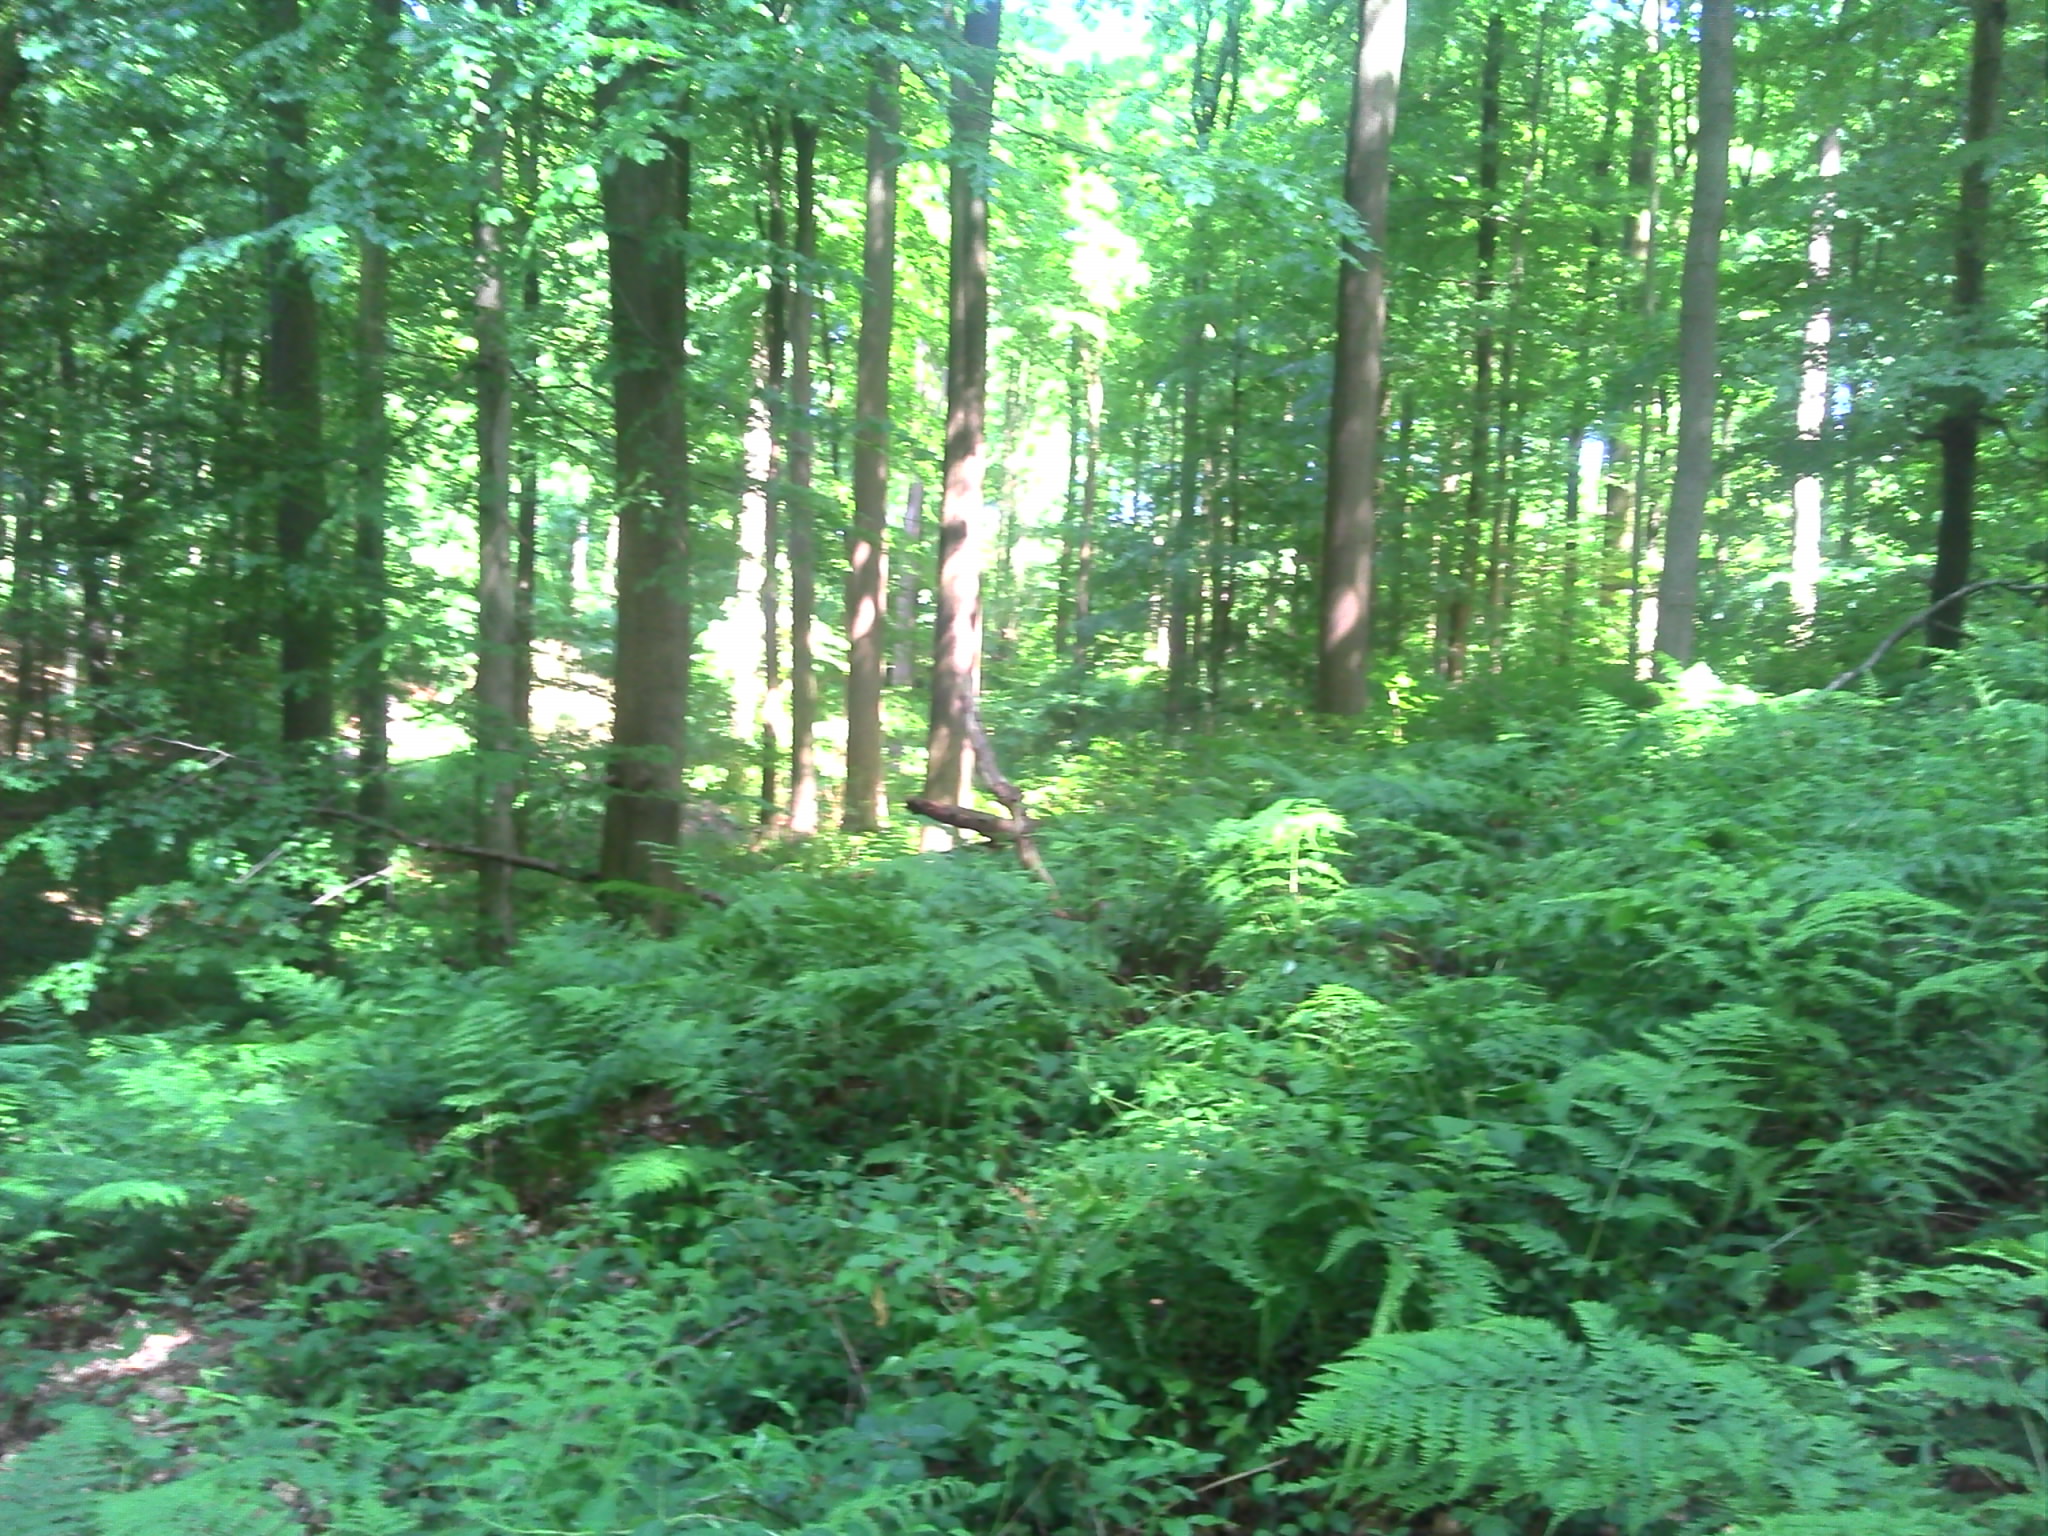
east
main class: Woodland
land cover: Broadleaved woodland
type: beech forest
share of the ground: > 75 %
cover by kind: broadleaved forest trees 90 %, herbaceous plants 10 %
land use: Forestry
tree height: > 5 m
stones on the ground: < 10 %
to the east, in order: Broadleaved woodland; Tracks; Broadleaved woodland
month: June
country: BE
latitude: 50.7522
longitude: 4.4536
